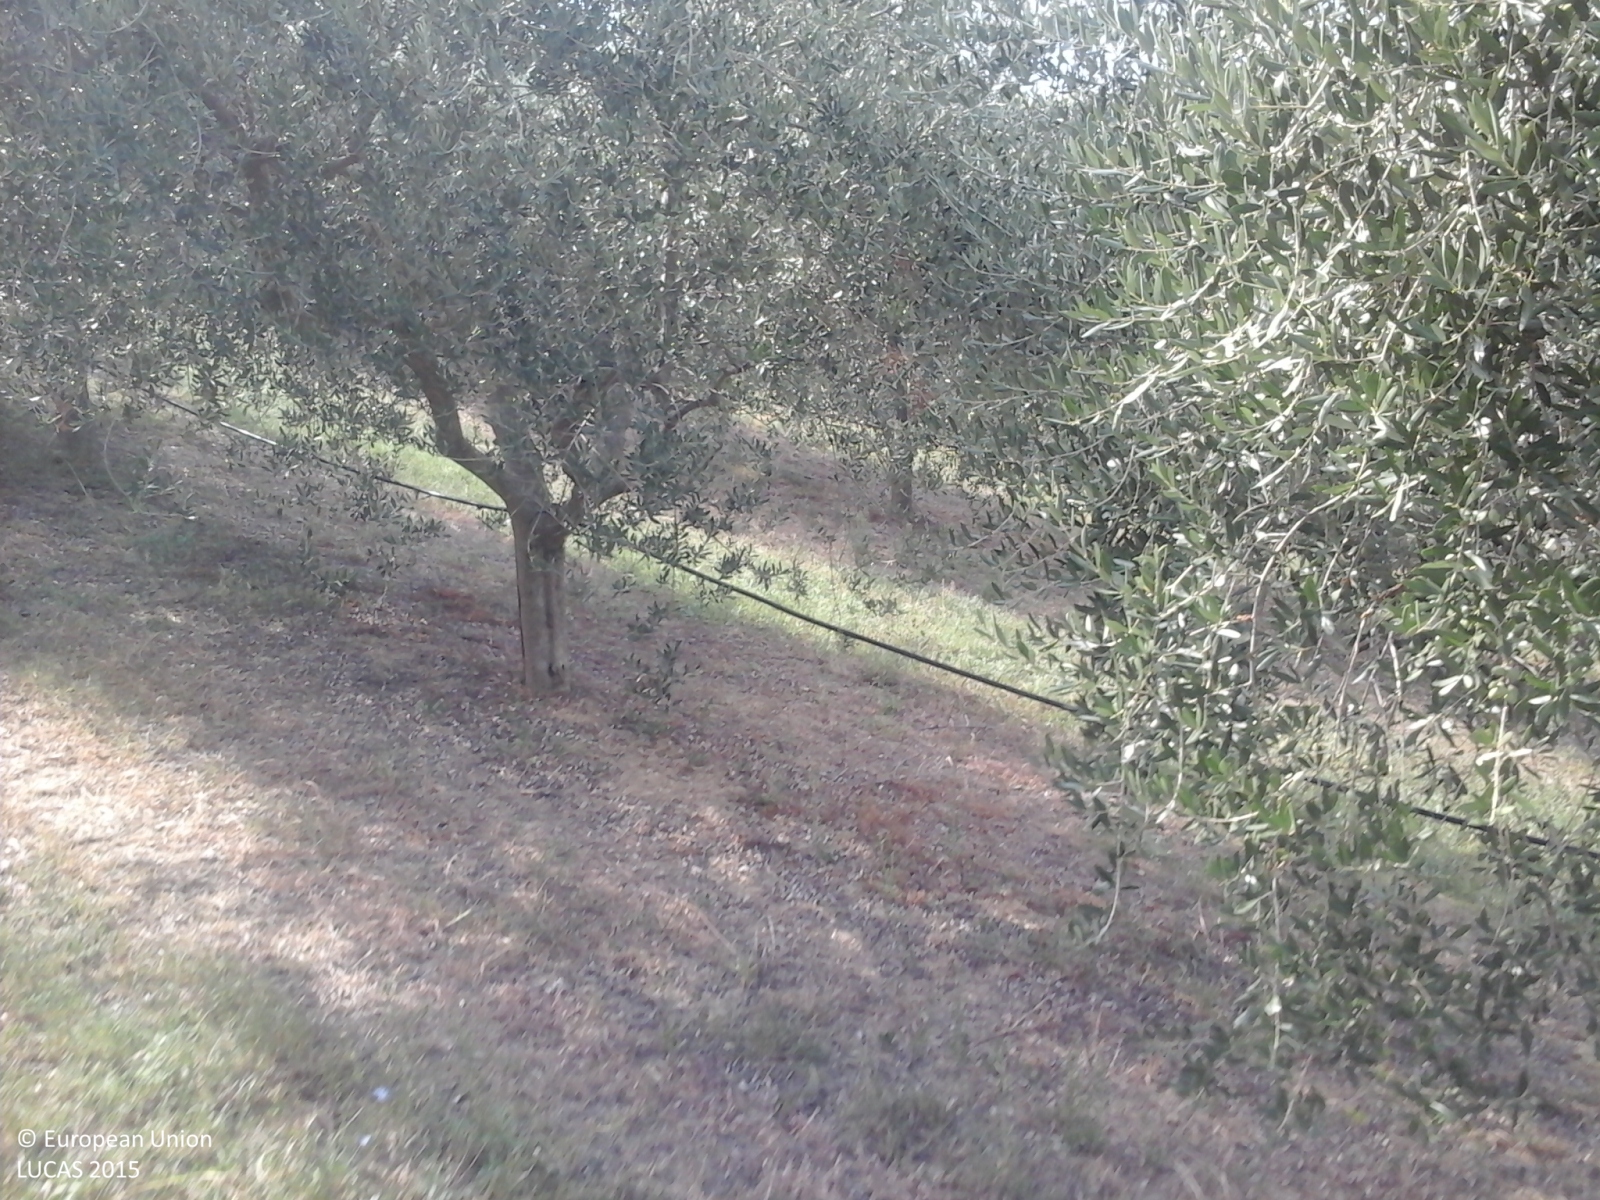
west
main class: Cropland
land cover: Olive groves
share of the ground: 50 - 75 %
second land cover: Grassland without tree/shrub cover
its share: > 75 %
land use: Agriculture (excluding fallow land and kitchen gardens)
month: September
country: IT
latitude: 43.8056
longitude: 12.8646
